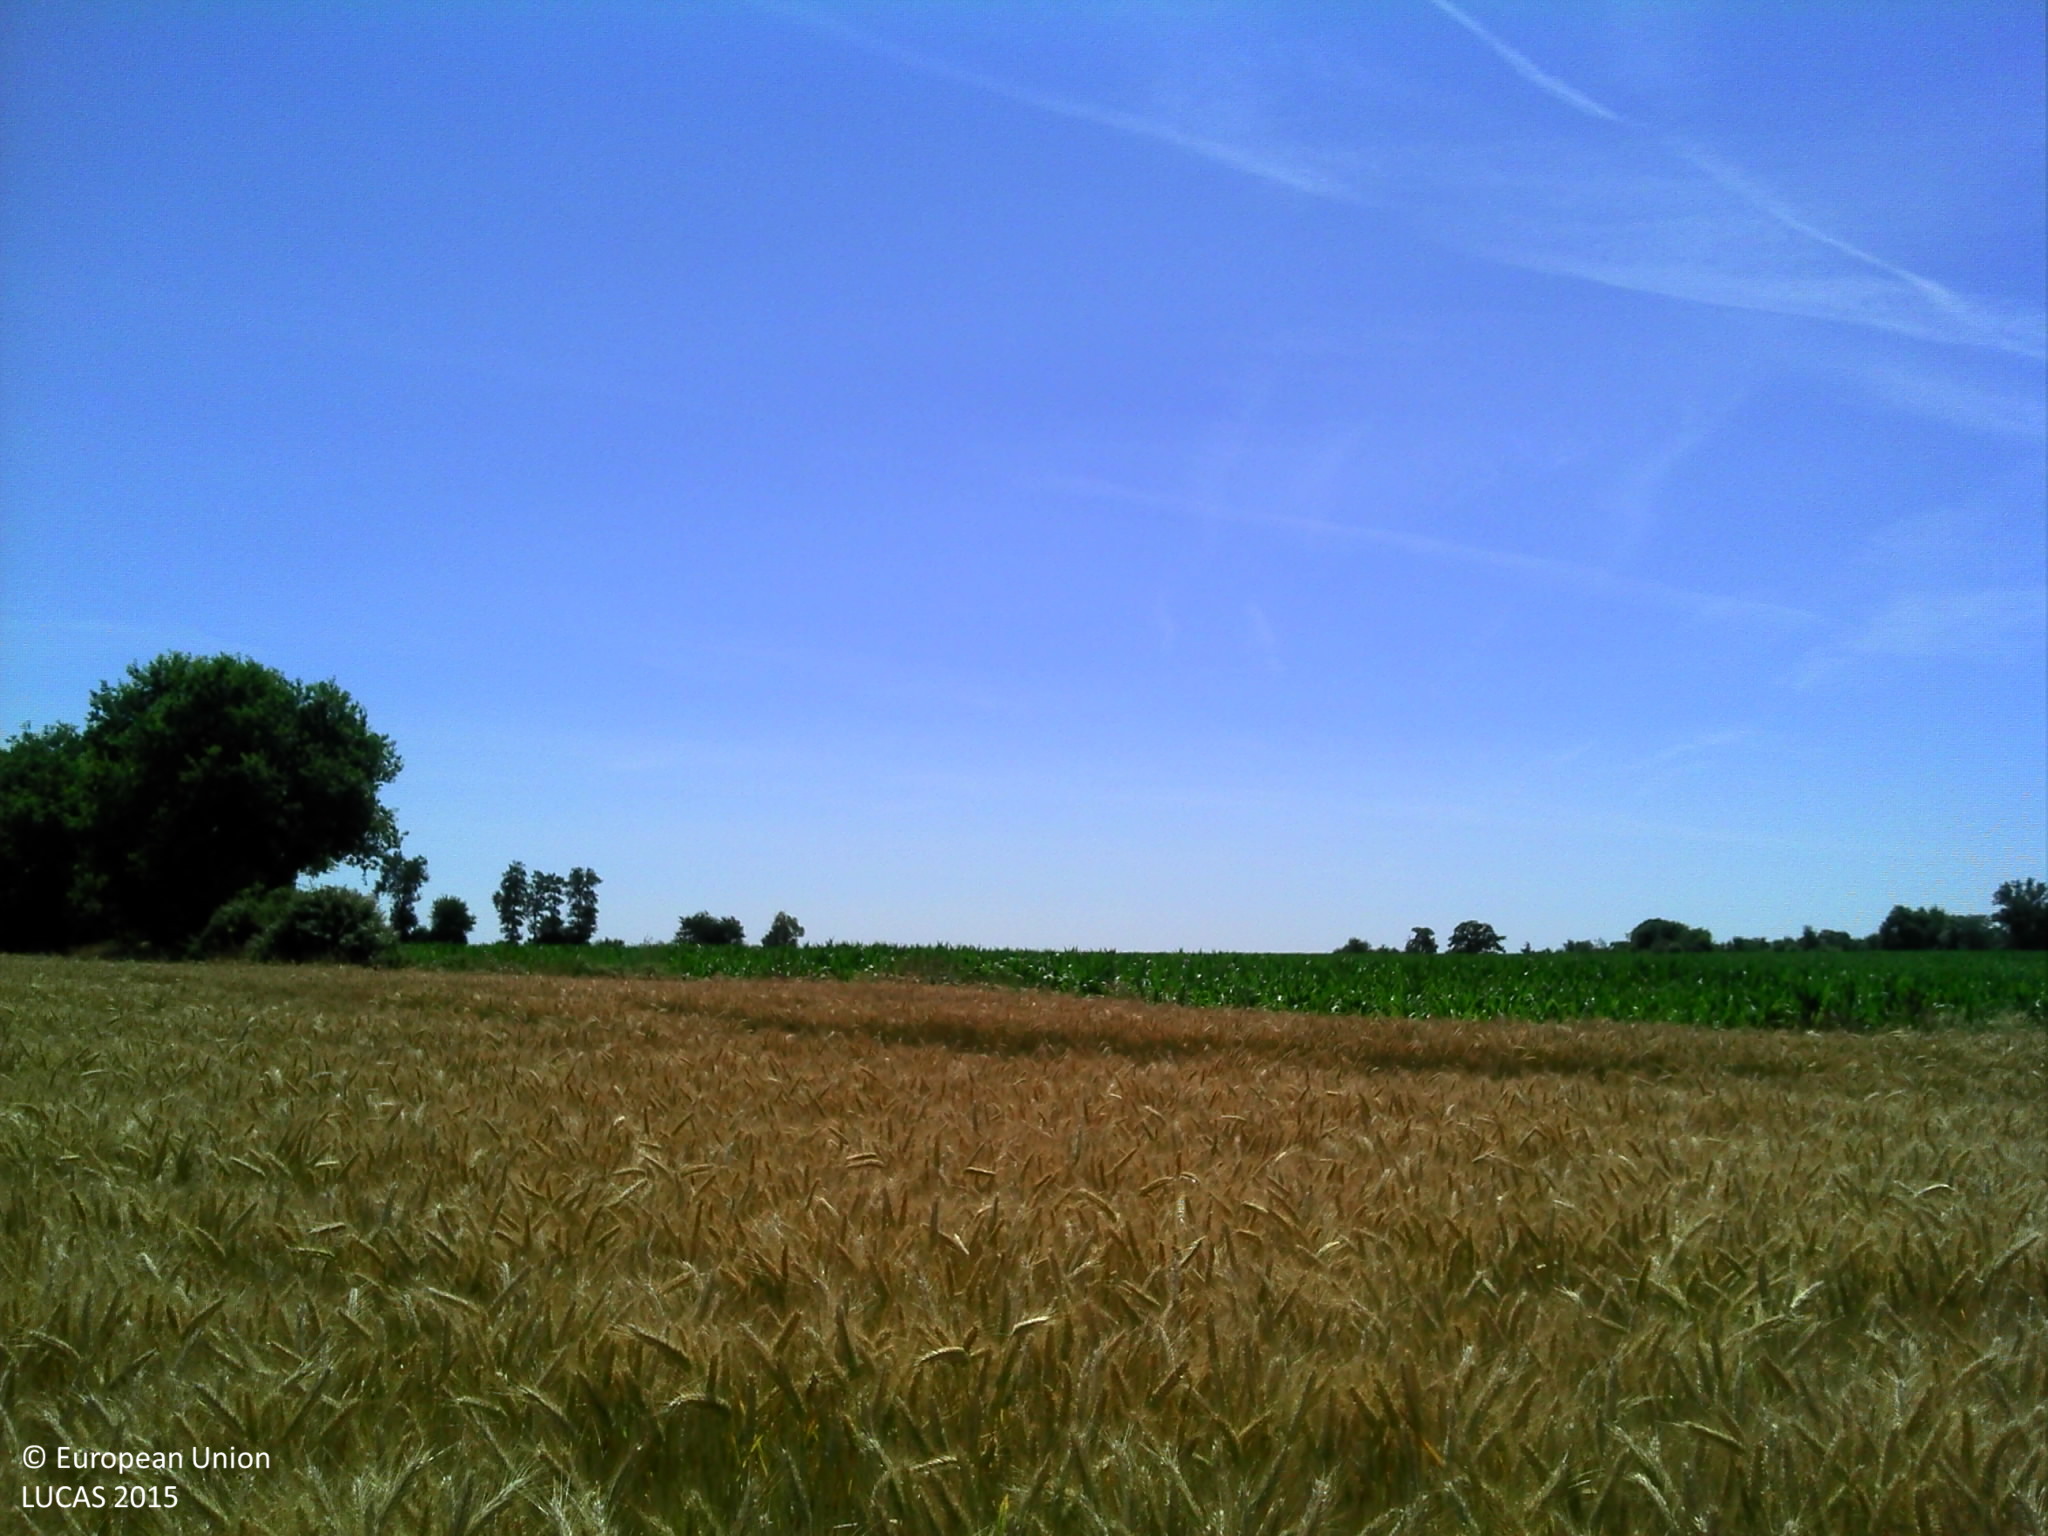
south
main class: Cropland
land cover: Durum wheat
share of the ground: > 75 %
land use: Agriculture (excluding fallow land and kitchen gardens)
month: July
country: FR
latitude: 48.2146
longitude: 0.5420
